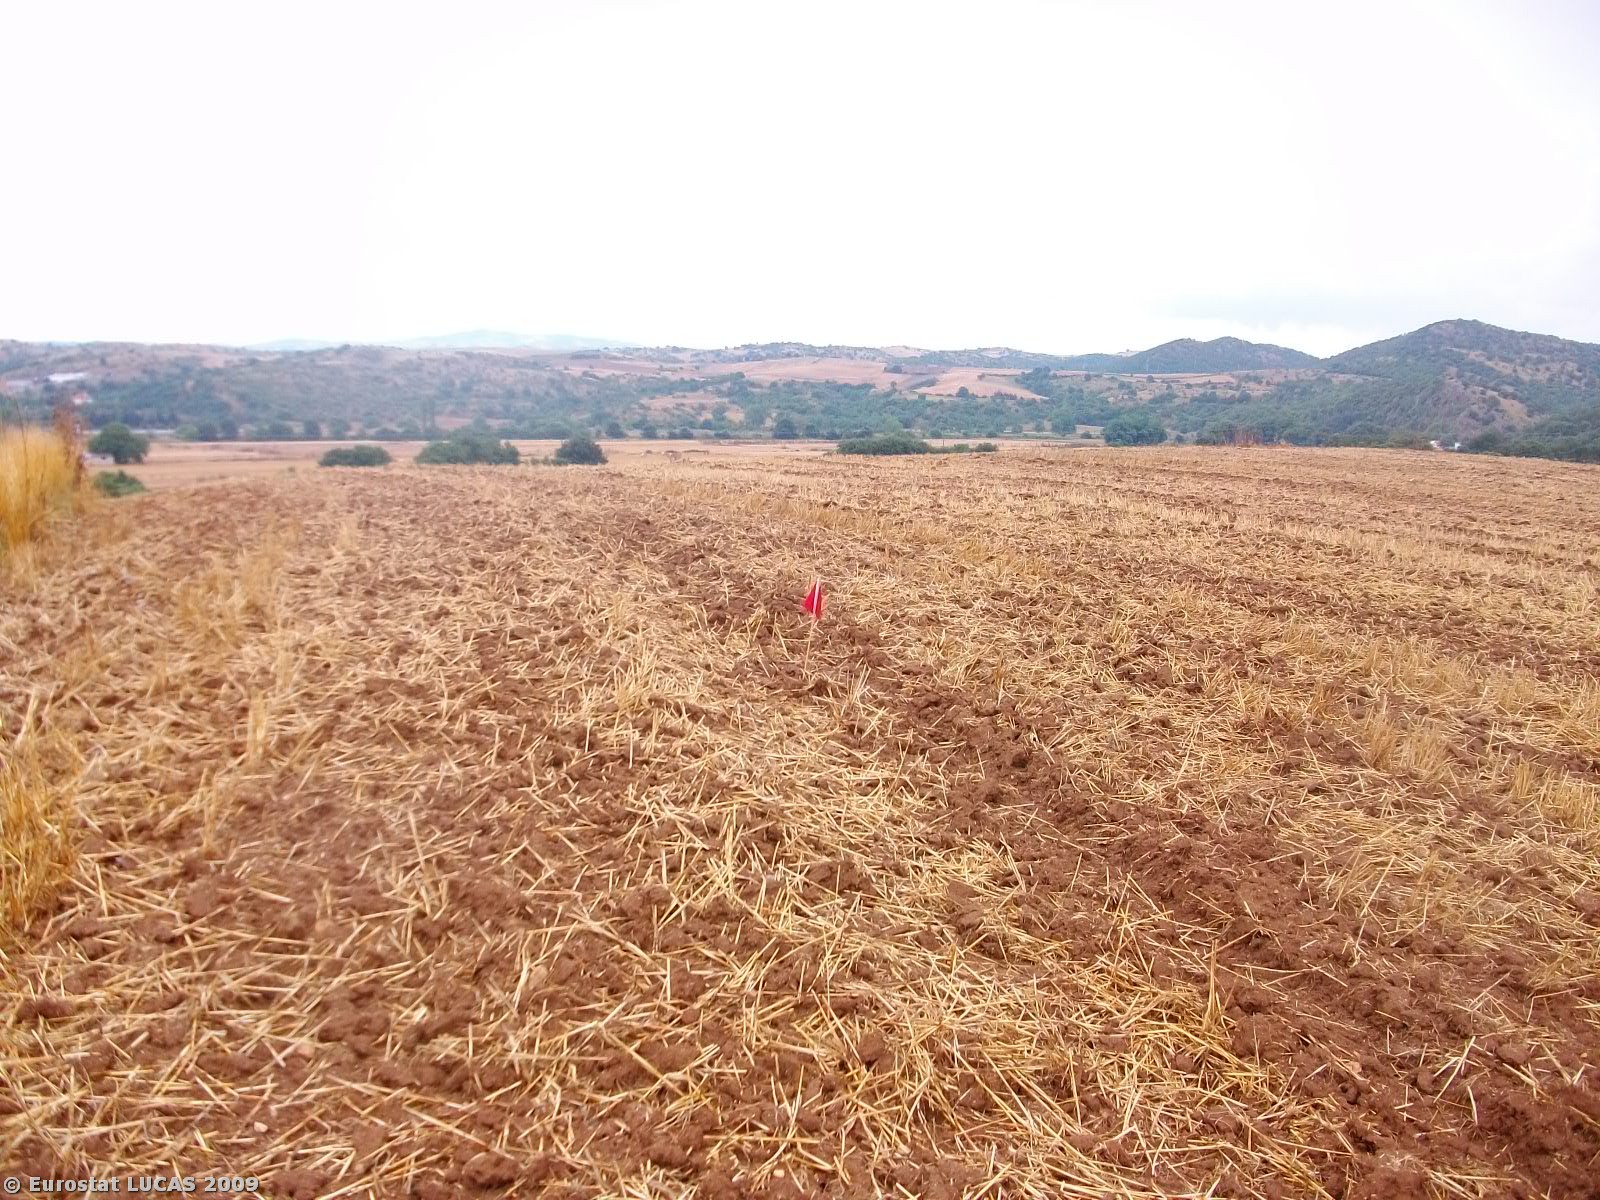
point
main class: Cropland
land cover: Barley
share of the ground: < 10 %
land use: Agriculture (excluding fallow land and kitchen gardens)
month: June
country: GR
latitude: 40.9808
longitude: 22.9300
